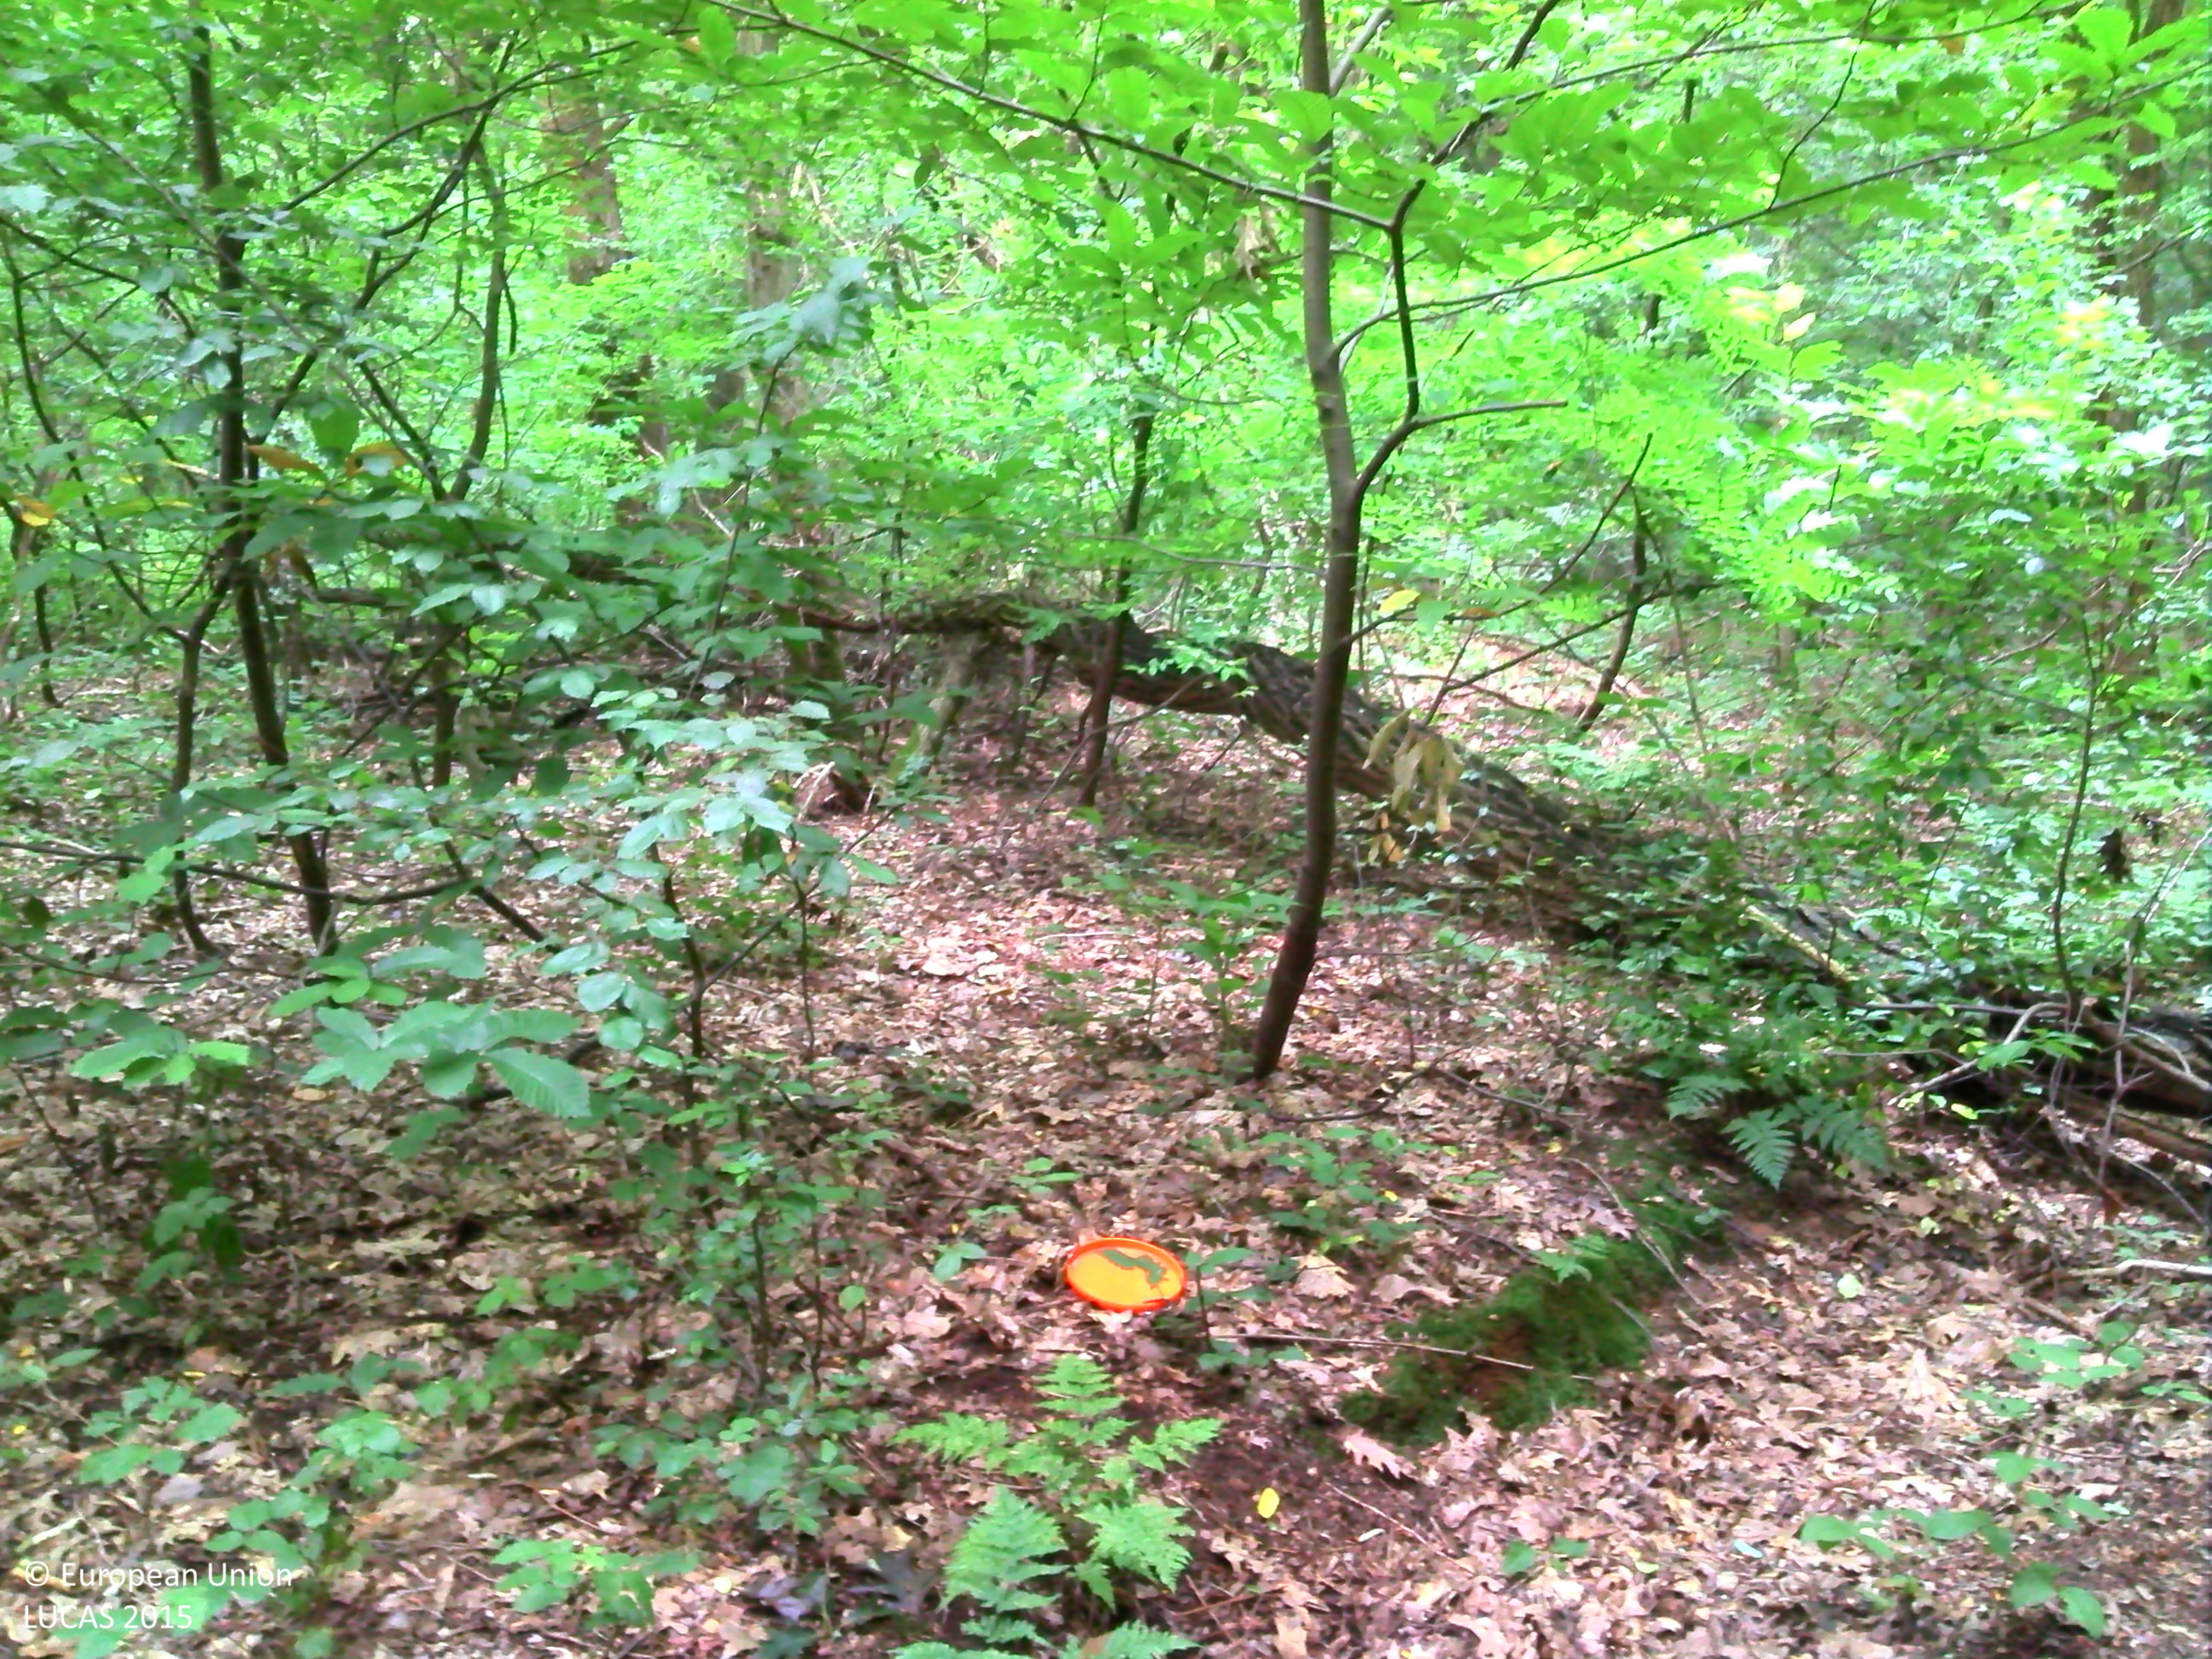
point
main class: Woodland
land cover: Broadleaved woodland
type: acidophilous oak and oak-birch forest
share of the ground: > 75 %
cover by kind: broadleaved forest trees 90 %, herbaceous plants 10 %
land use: Forestry
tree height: > 5 m
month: August
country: BE
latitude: 50.9678
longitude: 4.8276
